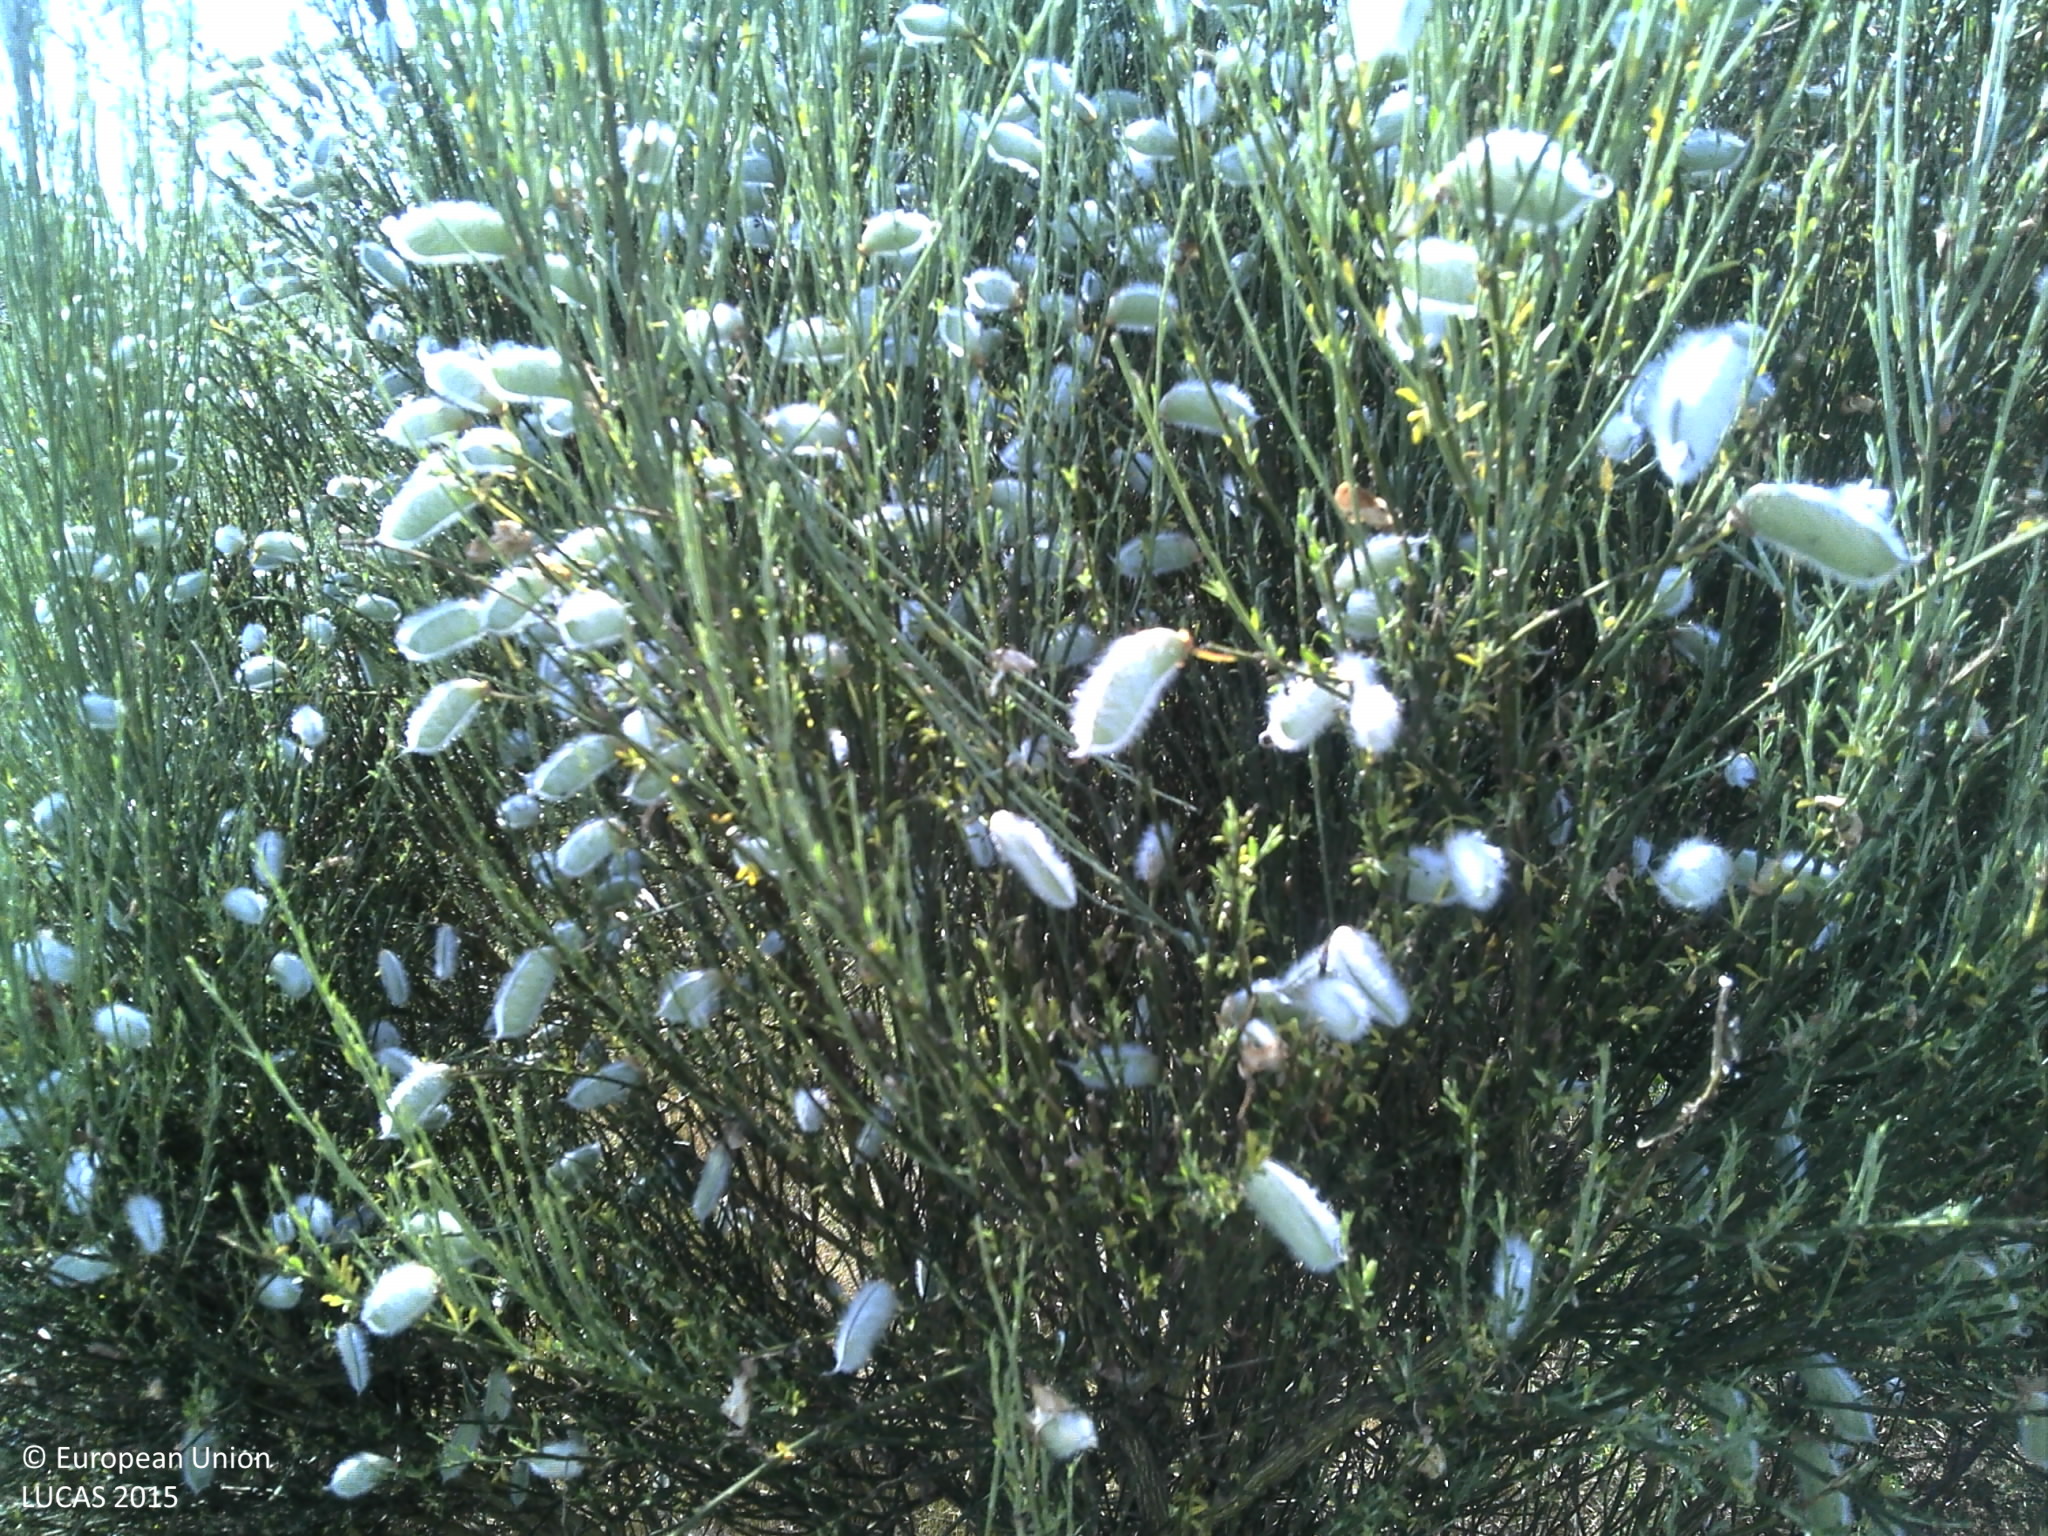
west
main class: Grassland
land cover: Grassland without tree/shrub cover
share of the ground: > 75 %
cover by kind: herbaceous plants 90 %, consolidated bare surface 5 %, unconsolidated bare surface 5 %
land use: Agriculture (excluding fallow land and kitchen gardens)
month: July
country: PT
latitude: 41.5033
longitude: -7.7076
